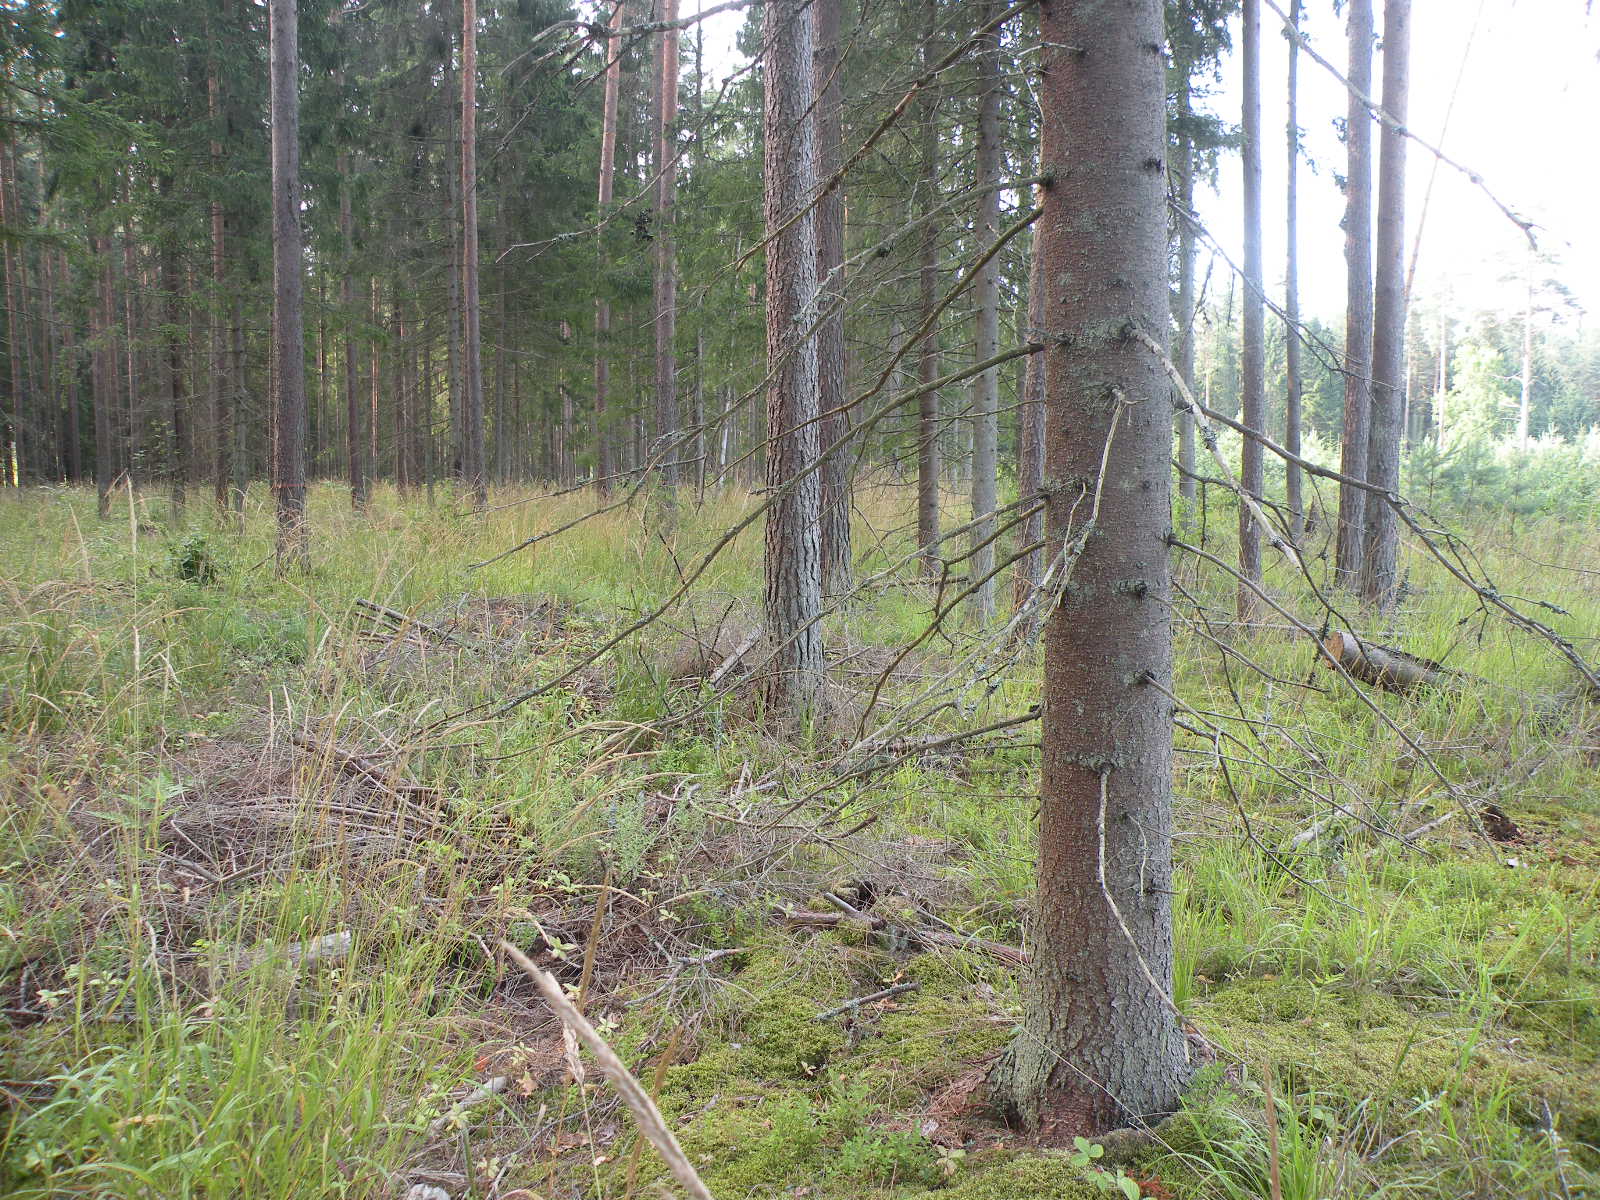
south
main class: Woodland
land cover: Spruce dominated coniferous woodland
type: hemiboreal forest and nemoral coniferous forest and mixed broadleaved-coniferous forest
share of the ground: 50 - 75 %
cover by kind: coniferous forest trees 60 %, herbaceous plants 30 %, unconsolidated bare surface 5 %
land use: Forestry
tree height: > 5 m
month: July
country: LV
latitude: 55.8949
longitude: 26.6748
